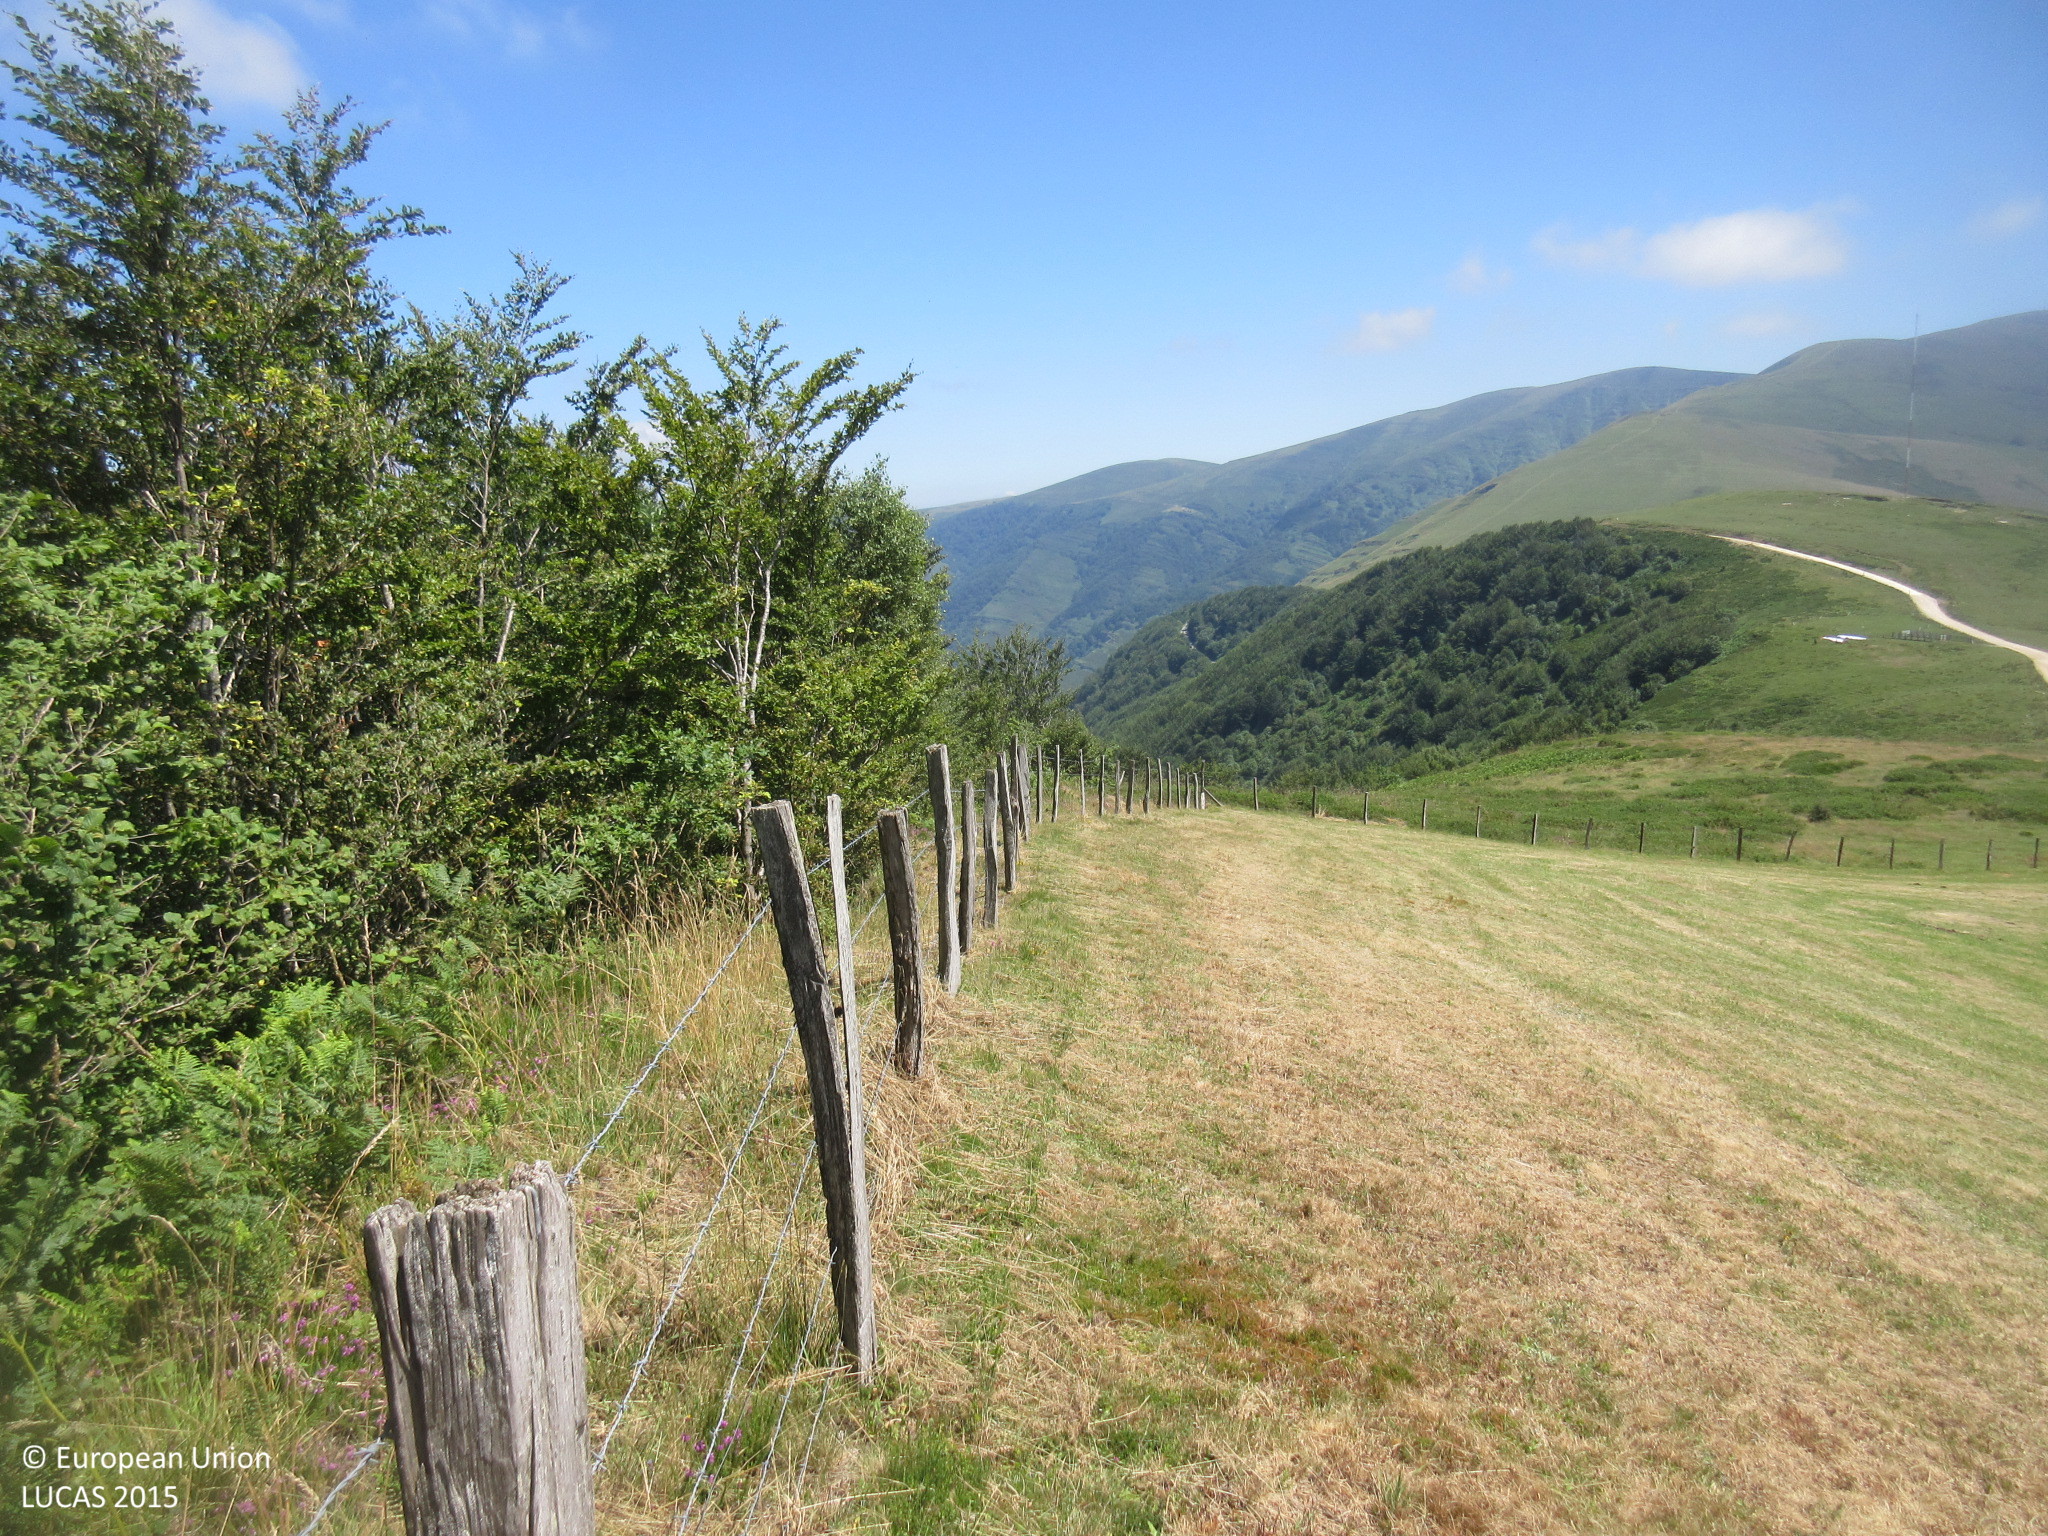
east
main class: Woodland
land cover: Broadleaved woodland
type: mountainous beech forest
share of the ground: > 75 %
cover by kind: broadleaved forest trees 100 %
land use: Semi-natural and natural areas not in use
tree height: > 5 m
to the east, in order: Broadleaved woodland; Grassland without tree/shrub cover
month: July
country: ES
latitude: 43.1587
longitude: -3.4584
